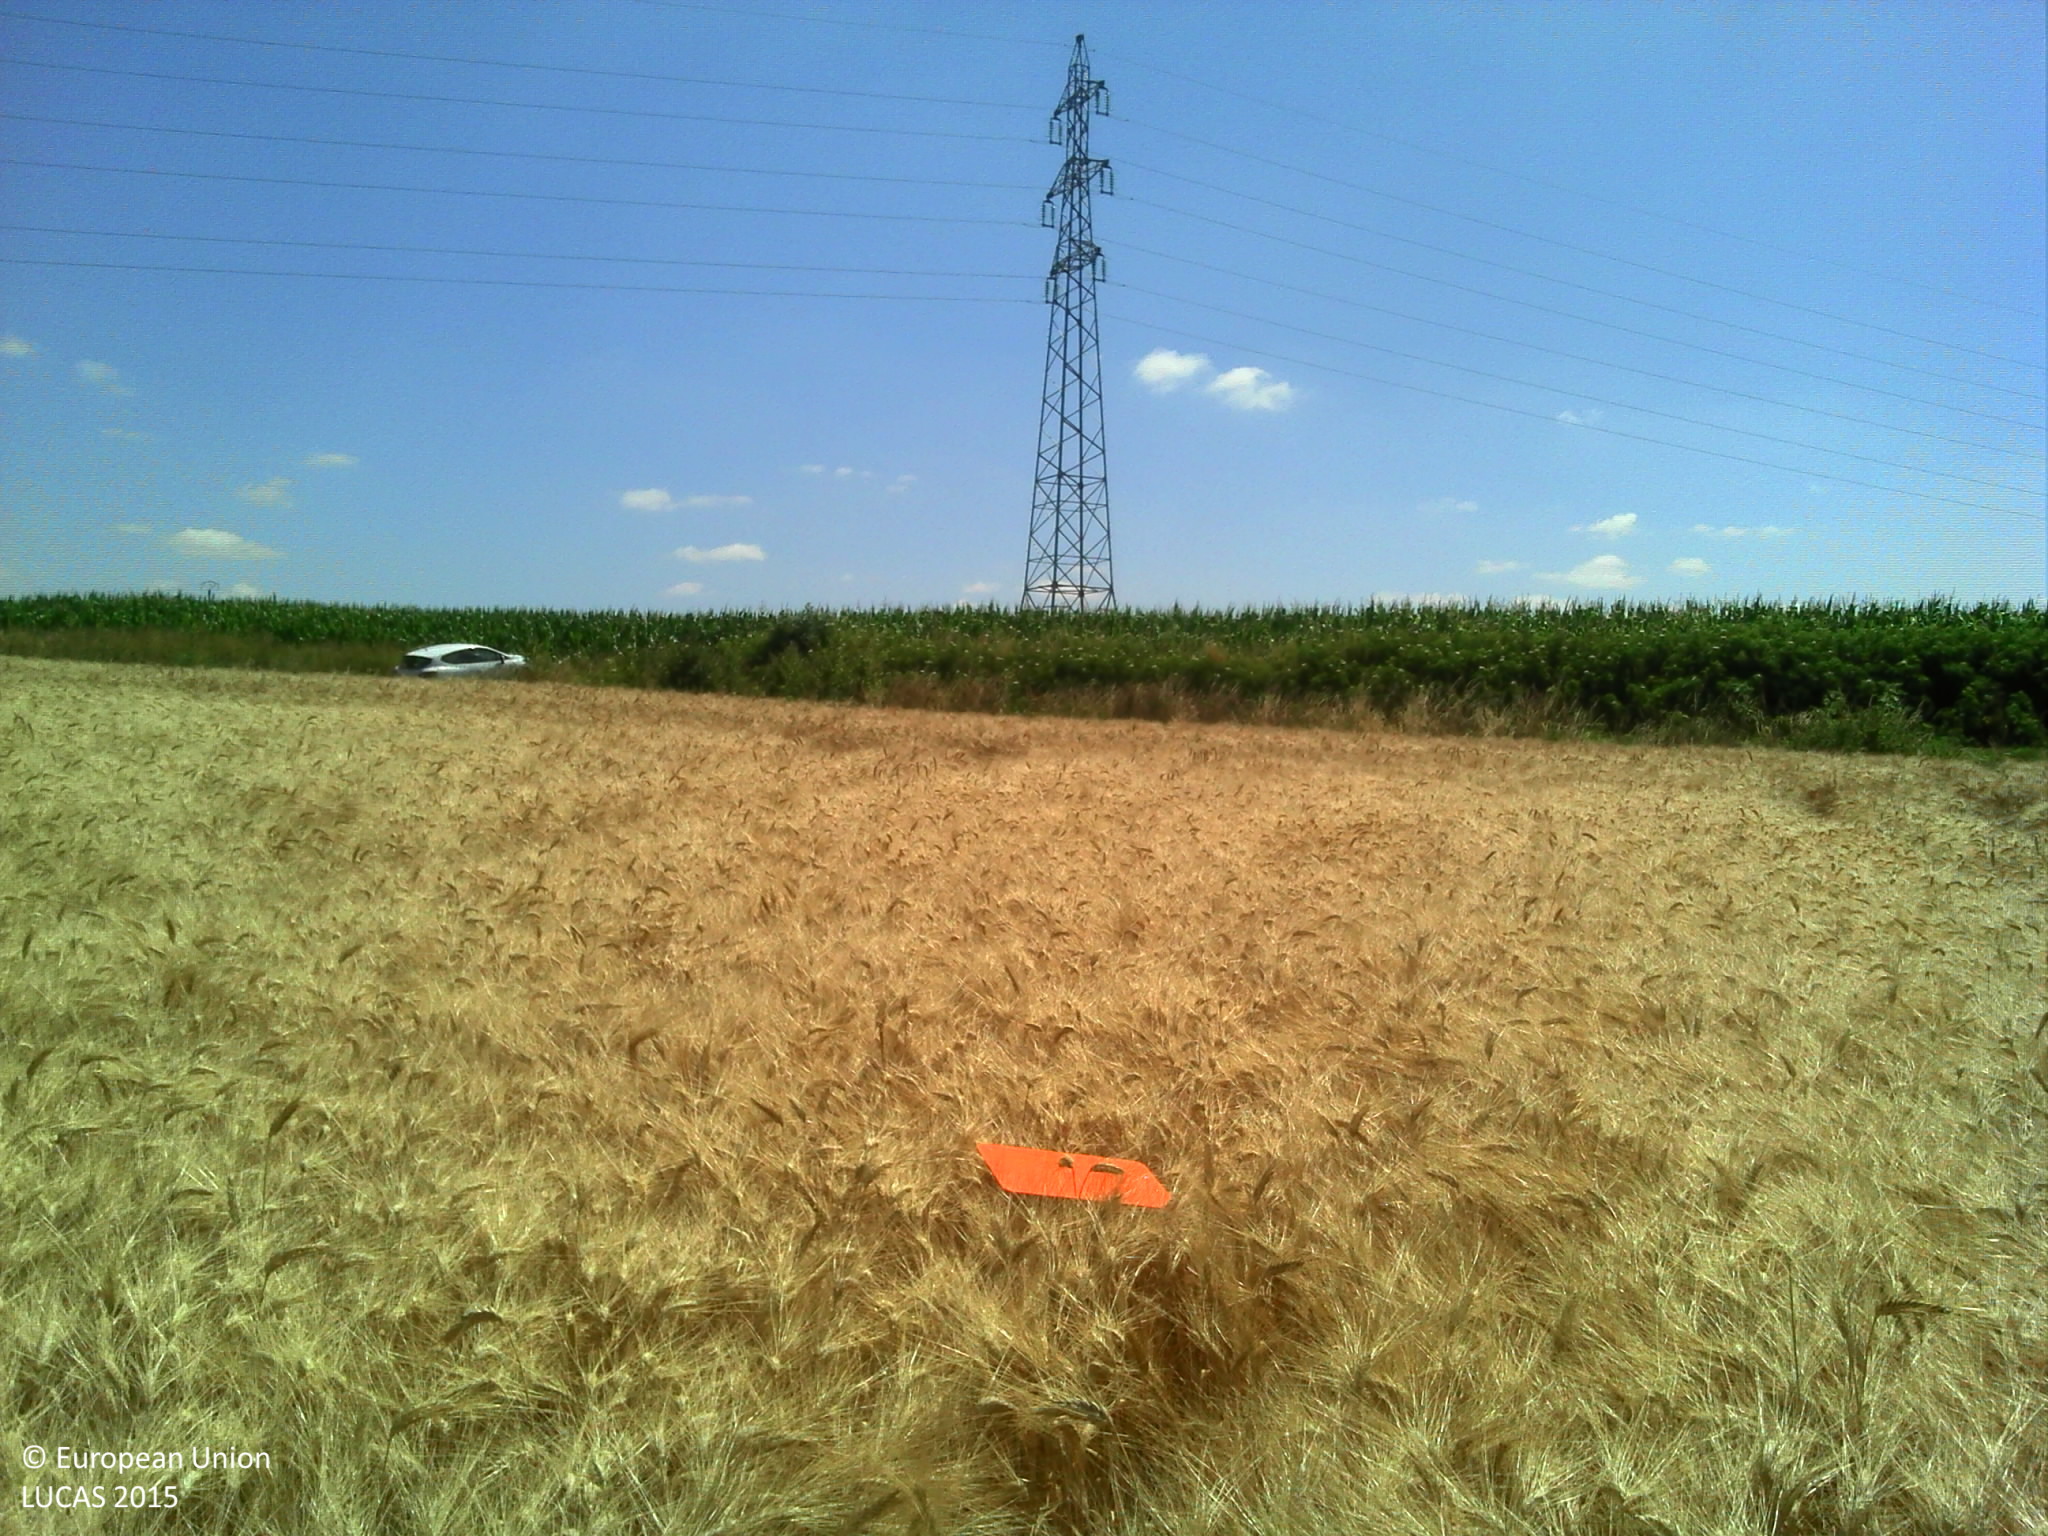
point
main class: Cropland
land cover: Common wheat
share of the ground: > 75 %
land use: Agriculture (excluding fallow land and kitchen gardens)
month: July
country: FR
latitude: 46.4390
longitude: -1.3199
